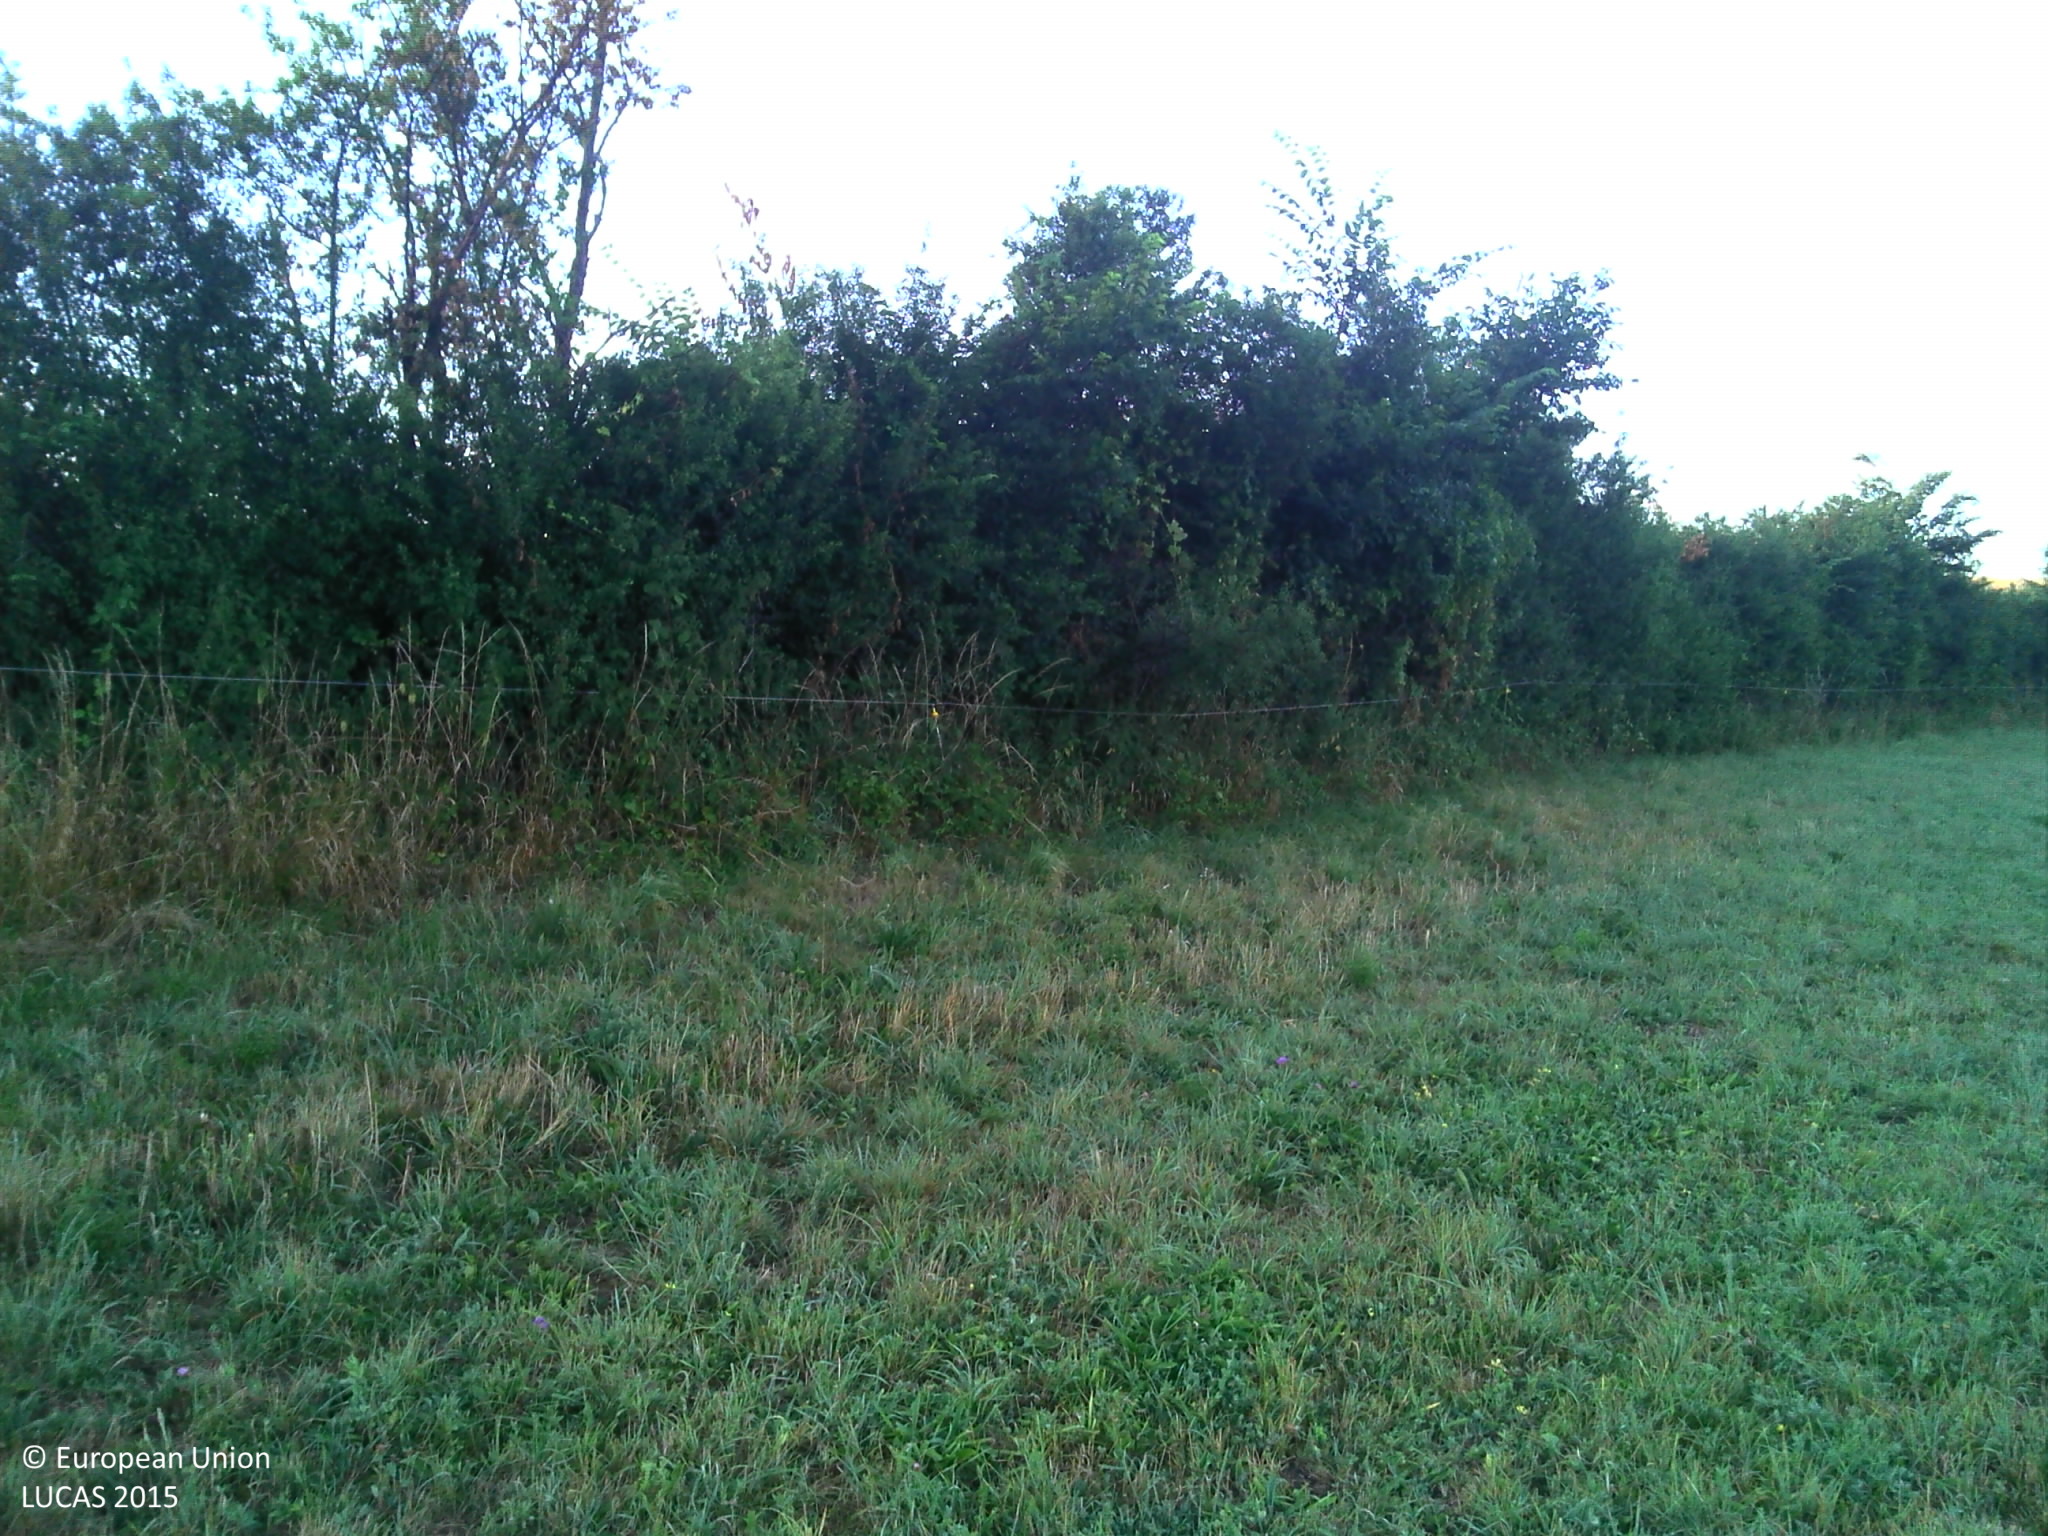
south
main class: Grassland
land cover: Grassland without tree/shrub cover
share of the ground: > 75 %
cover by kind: herbaceous plants 100 %
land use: Agriculture (excluding fallow land and kitchen gardens)
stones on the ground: < 10 %
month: July
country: FR
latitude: 45.1580
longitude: 3.4771
